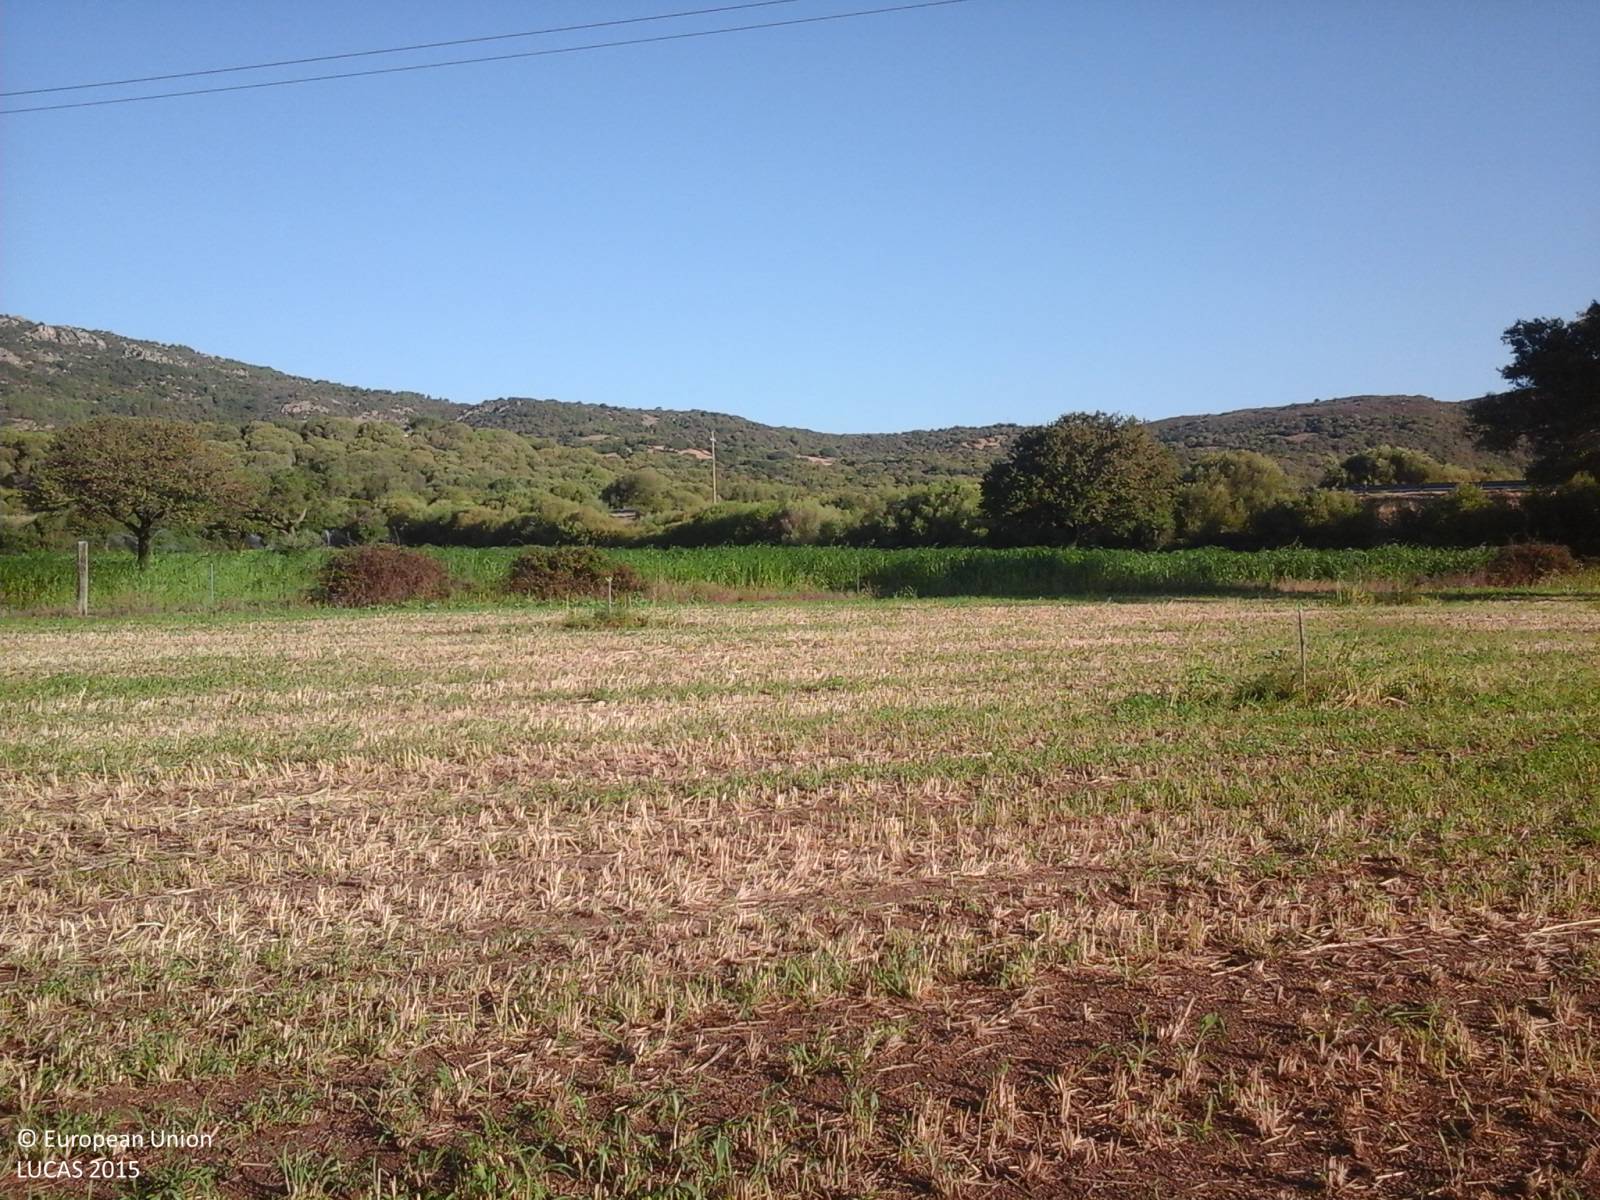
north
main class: Grassland
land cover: Grassland without tree/shrub cover
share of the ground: > 75 %
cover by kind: herbaceous plants 95 %, unconsolidated bare surface 5 %
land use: Agriculture (excluding fallow land and kitchen gardens)
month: August
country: IT
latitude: 40.9352
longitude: 9.4208
